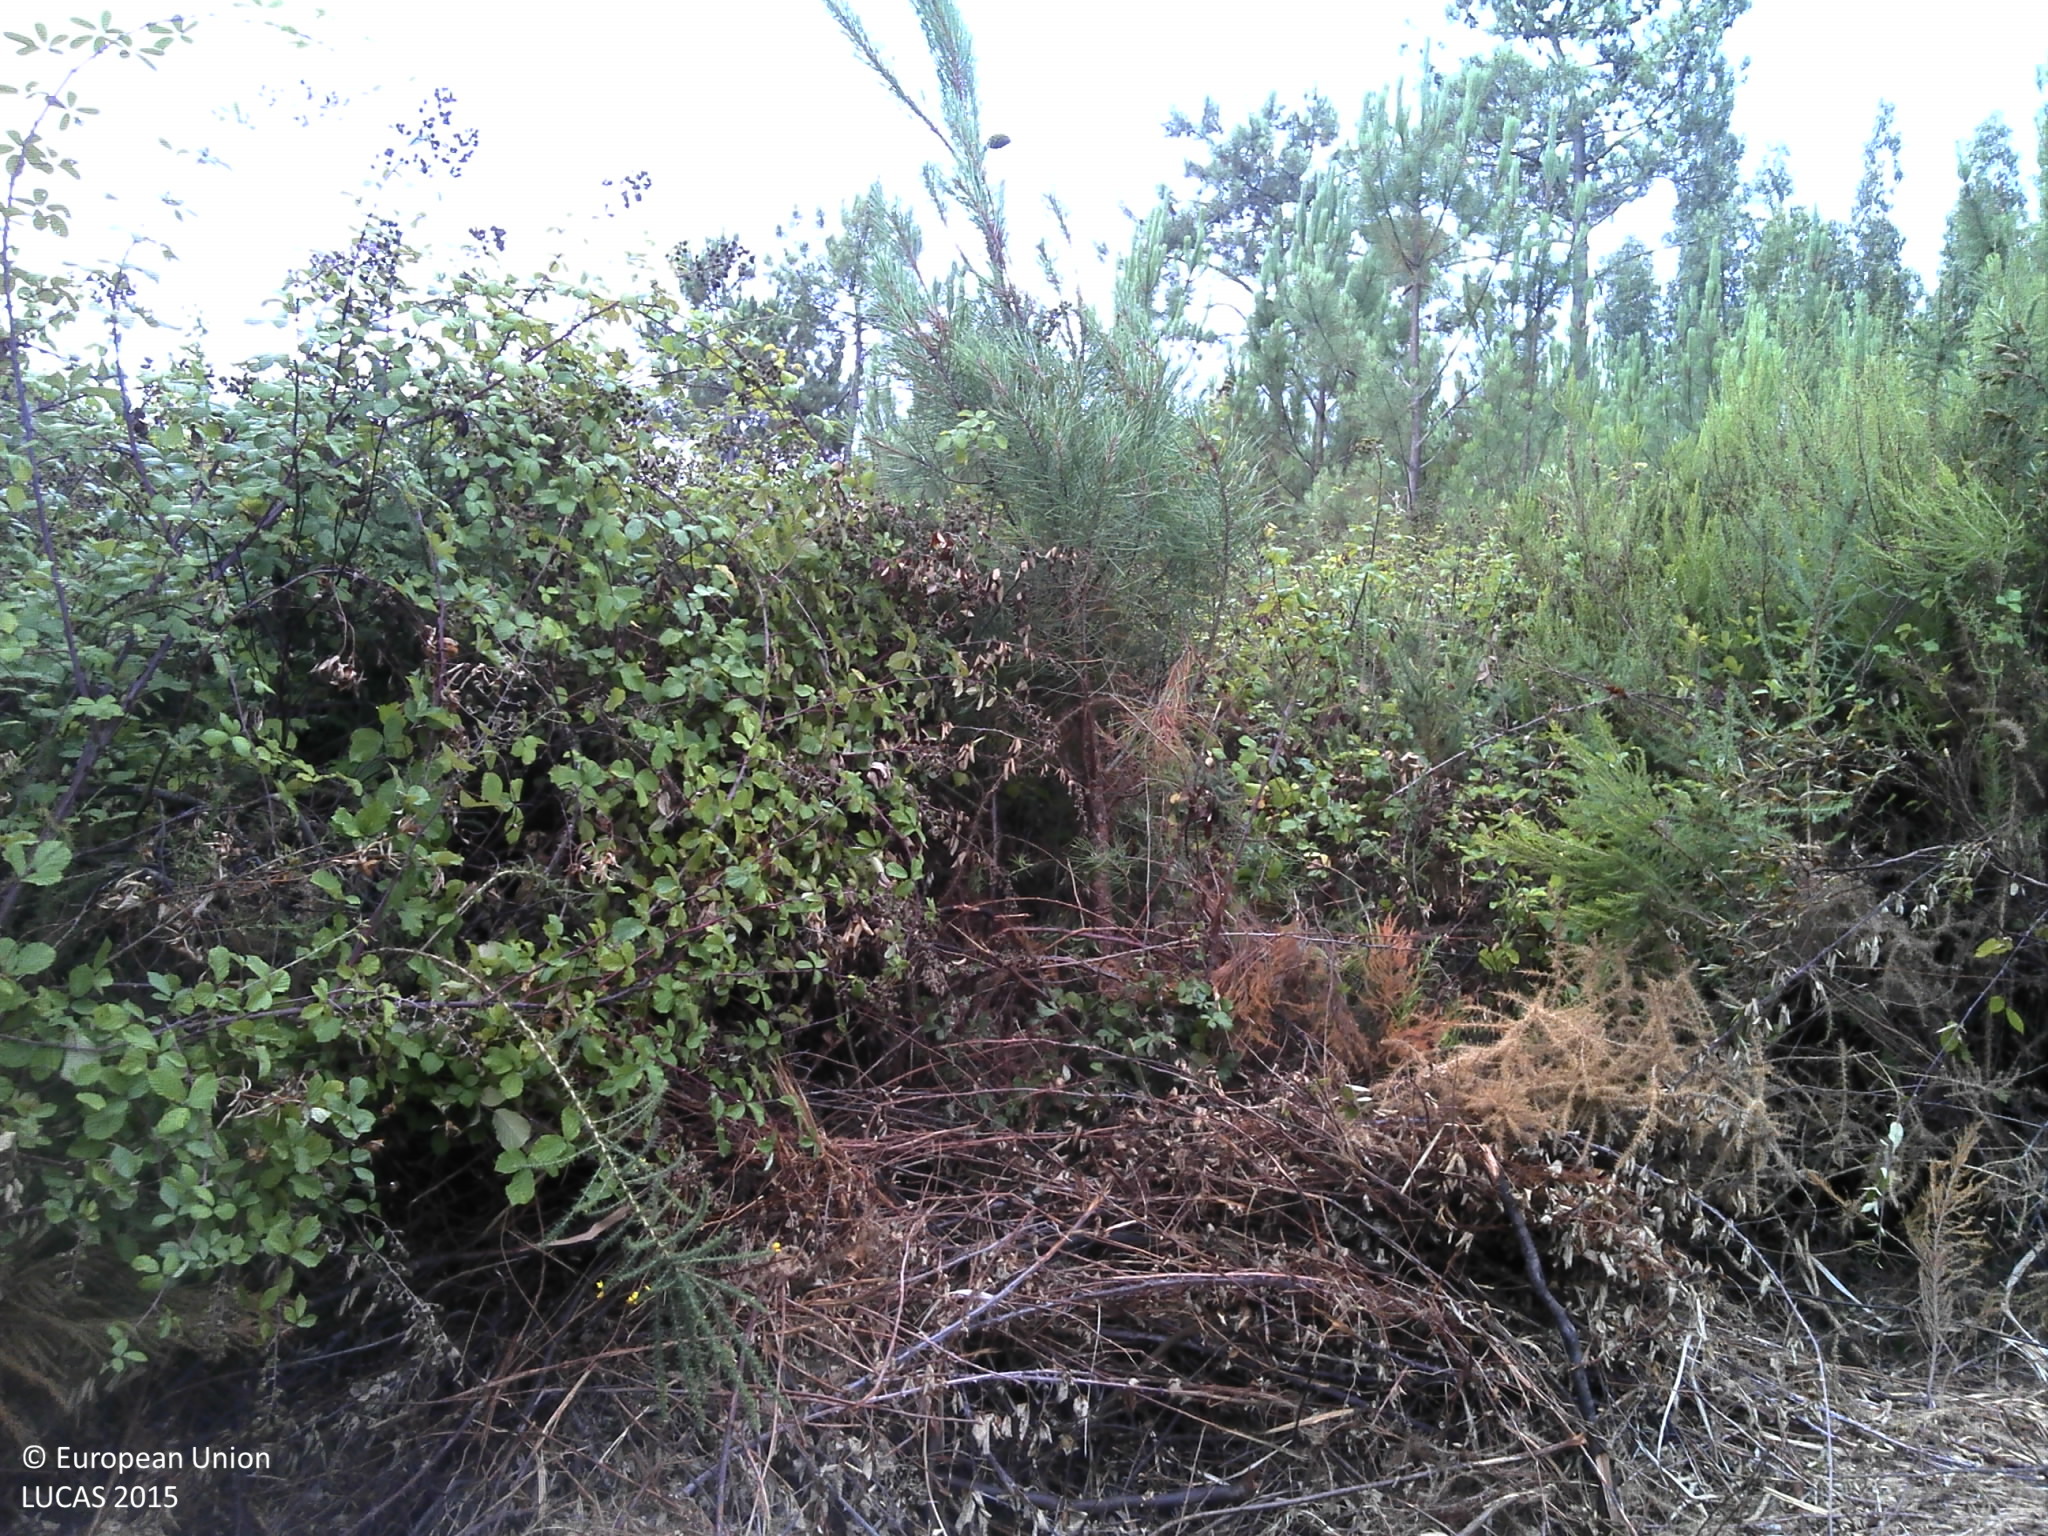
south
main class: Shrubland
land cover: Shrubland without tree cover
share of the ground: > 75 %
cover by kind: shrubs 80 %, unconsolidated bare surface 20 %
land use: Forestry
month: July
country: PT
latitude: 37.3850
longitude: -8.7508
